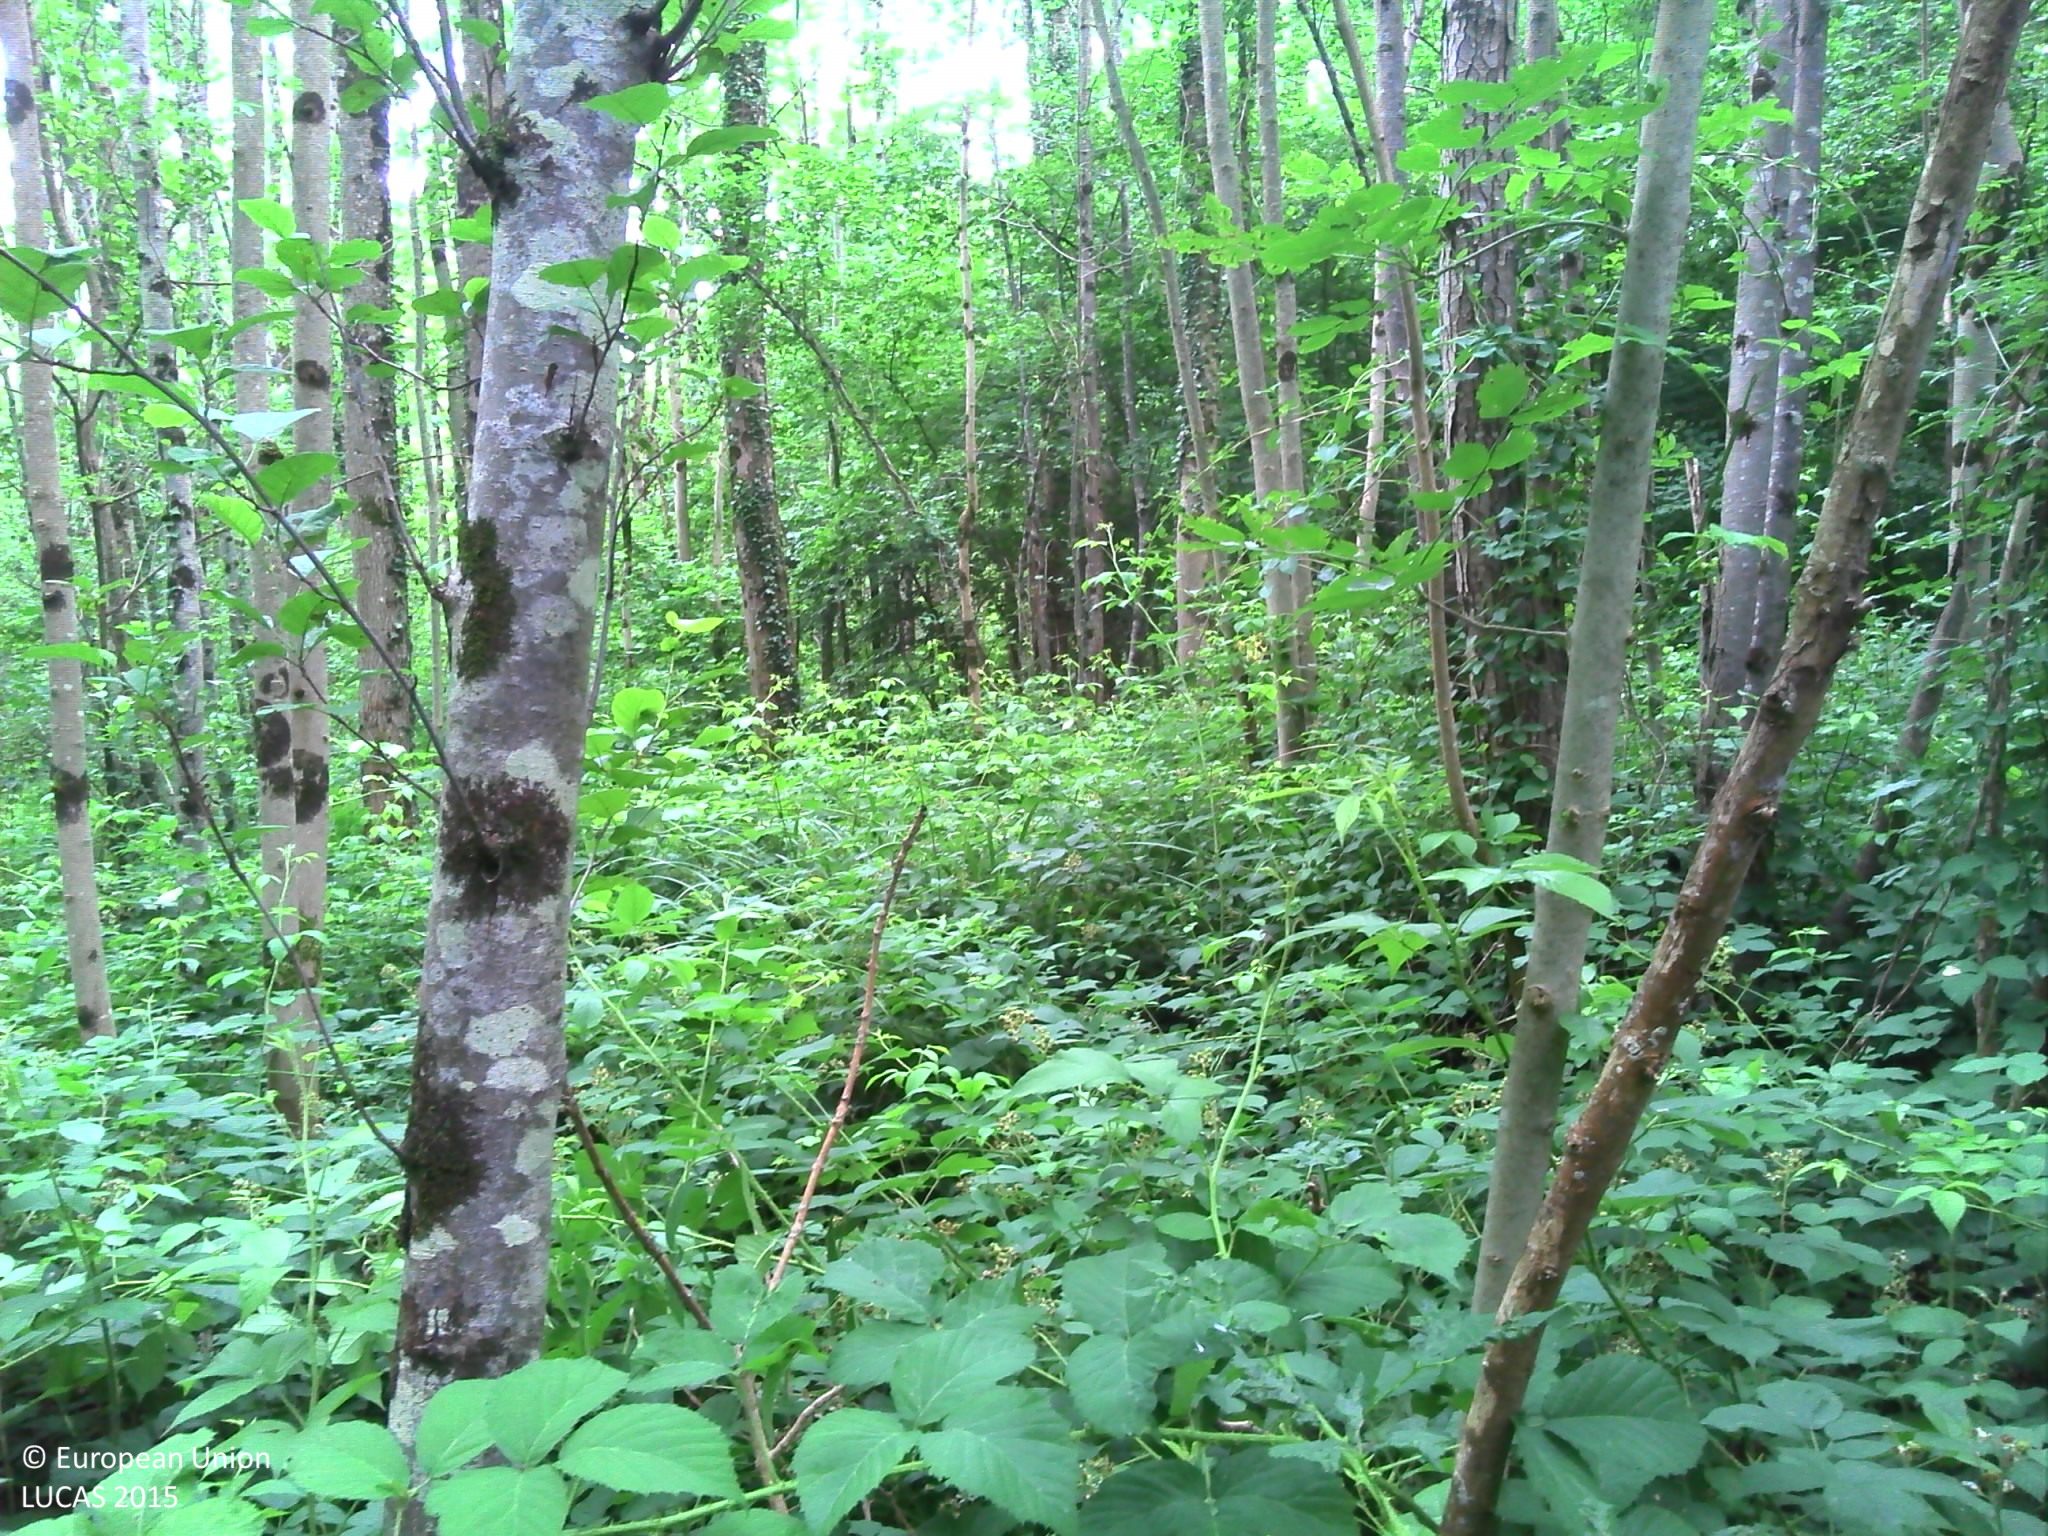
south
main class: Woodland
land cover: Broadleaved woodland
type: non-riverine alder, birch or aspen forest
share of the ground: > 75 %
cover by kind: broadleaved forest trees 70 %, shrubs 30 %
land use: Forestry
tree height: > 5 m
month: June
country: FR
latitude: 46.7789
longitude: 5.4835
